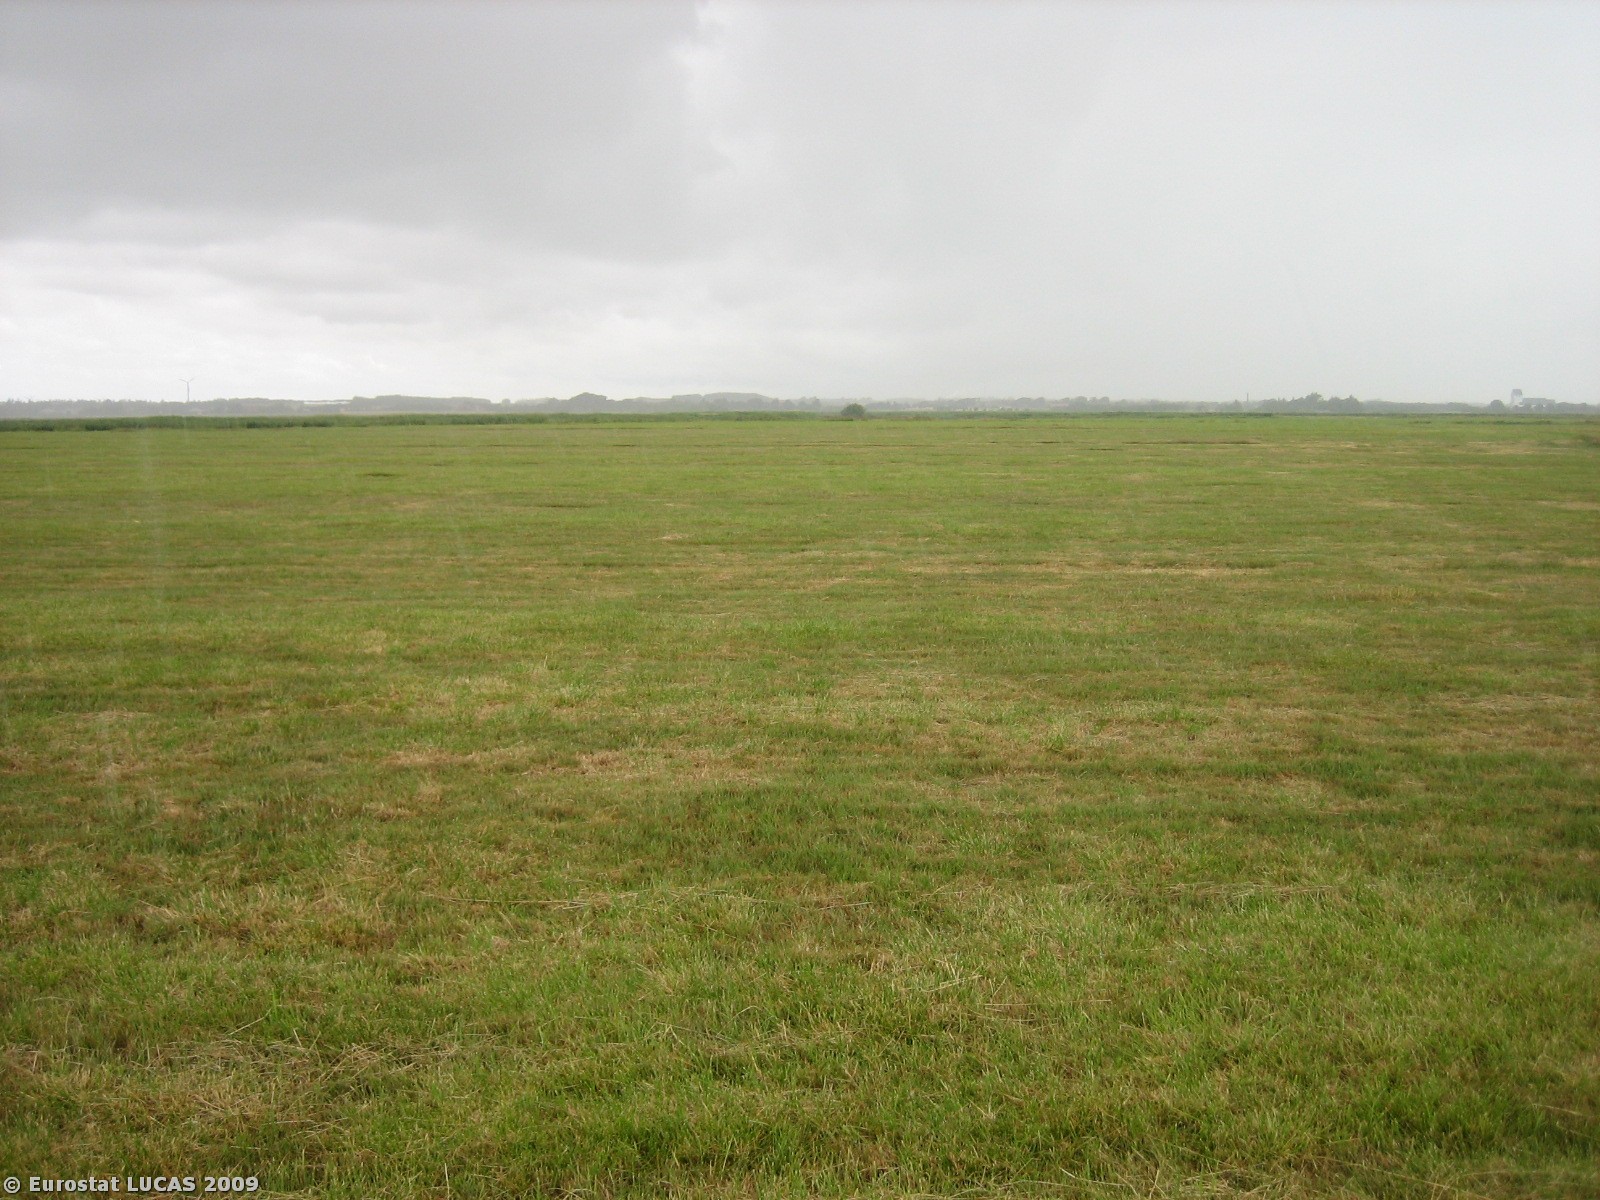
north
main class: Grassland
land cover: Grassland without tree/shrub cover
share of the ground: > 75 %
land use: Agriculture (excluding fallow land and kitchen gardens)
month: July
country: DK
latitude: 55.6020
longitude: 8.3667
